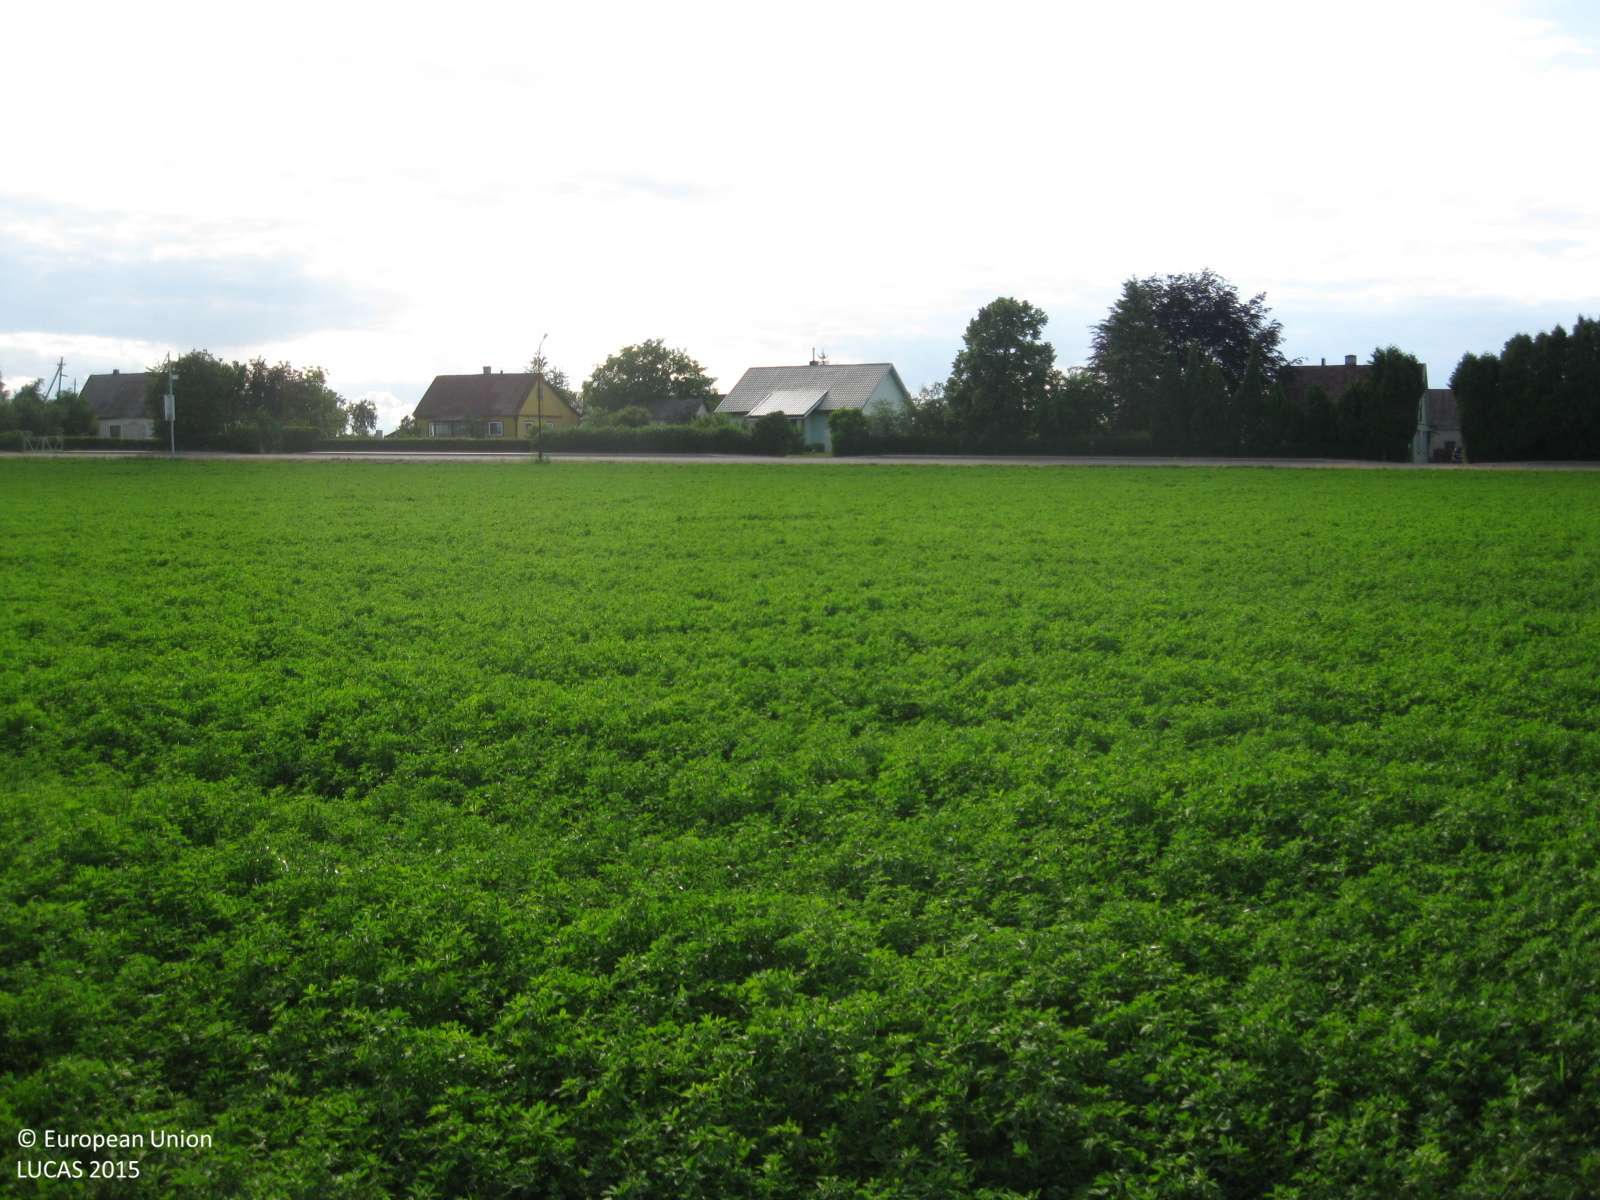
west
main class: Cropland
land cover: Clovers
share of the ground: > 75 %
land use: Agriculture (excluding fallow land and kitchen gardens)
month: June
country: LT
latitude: 55.1892
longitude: 23.8945
